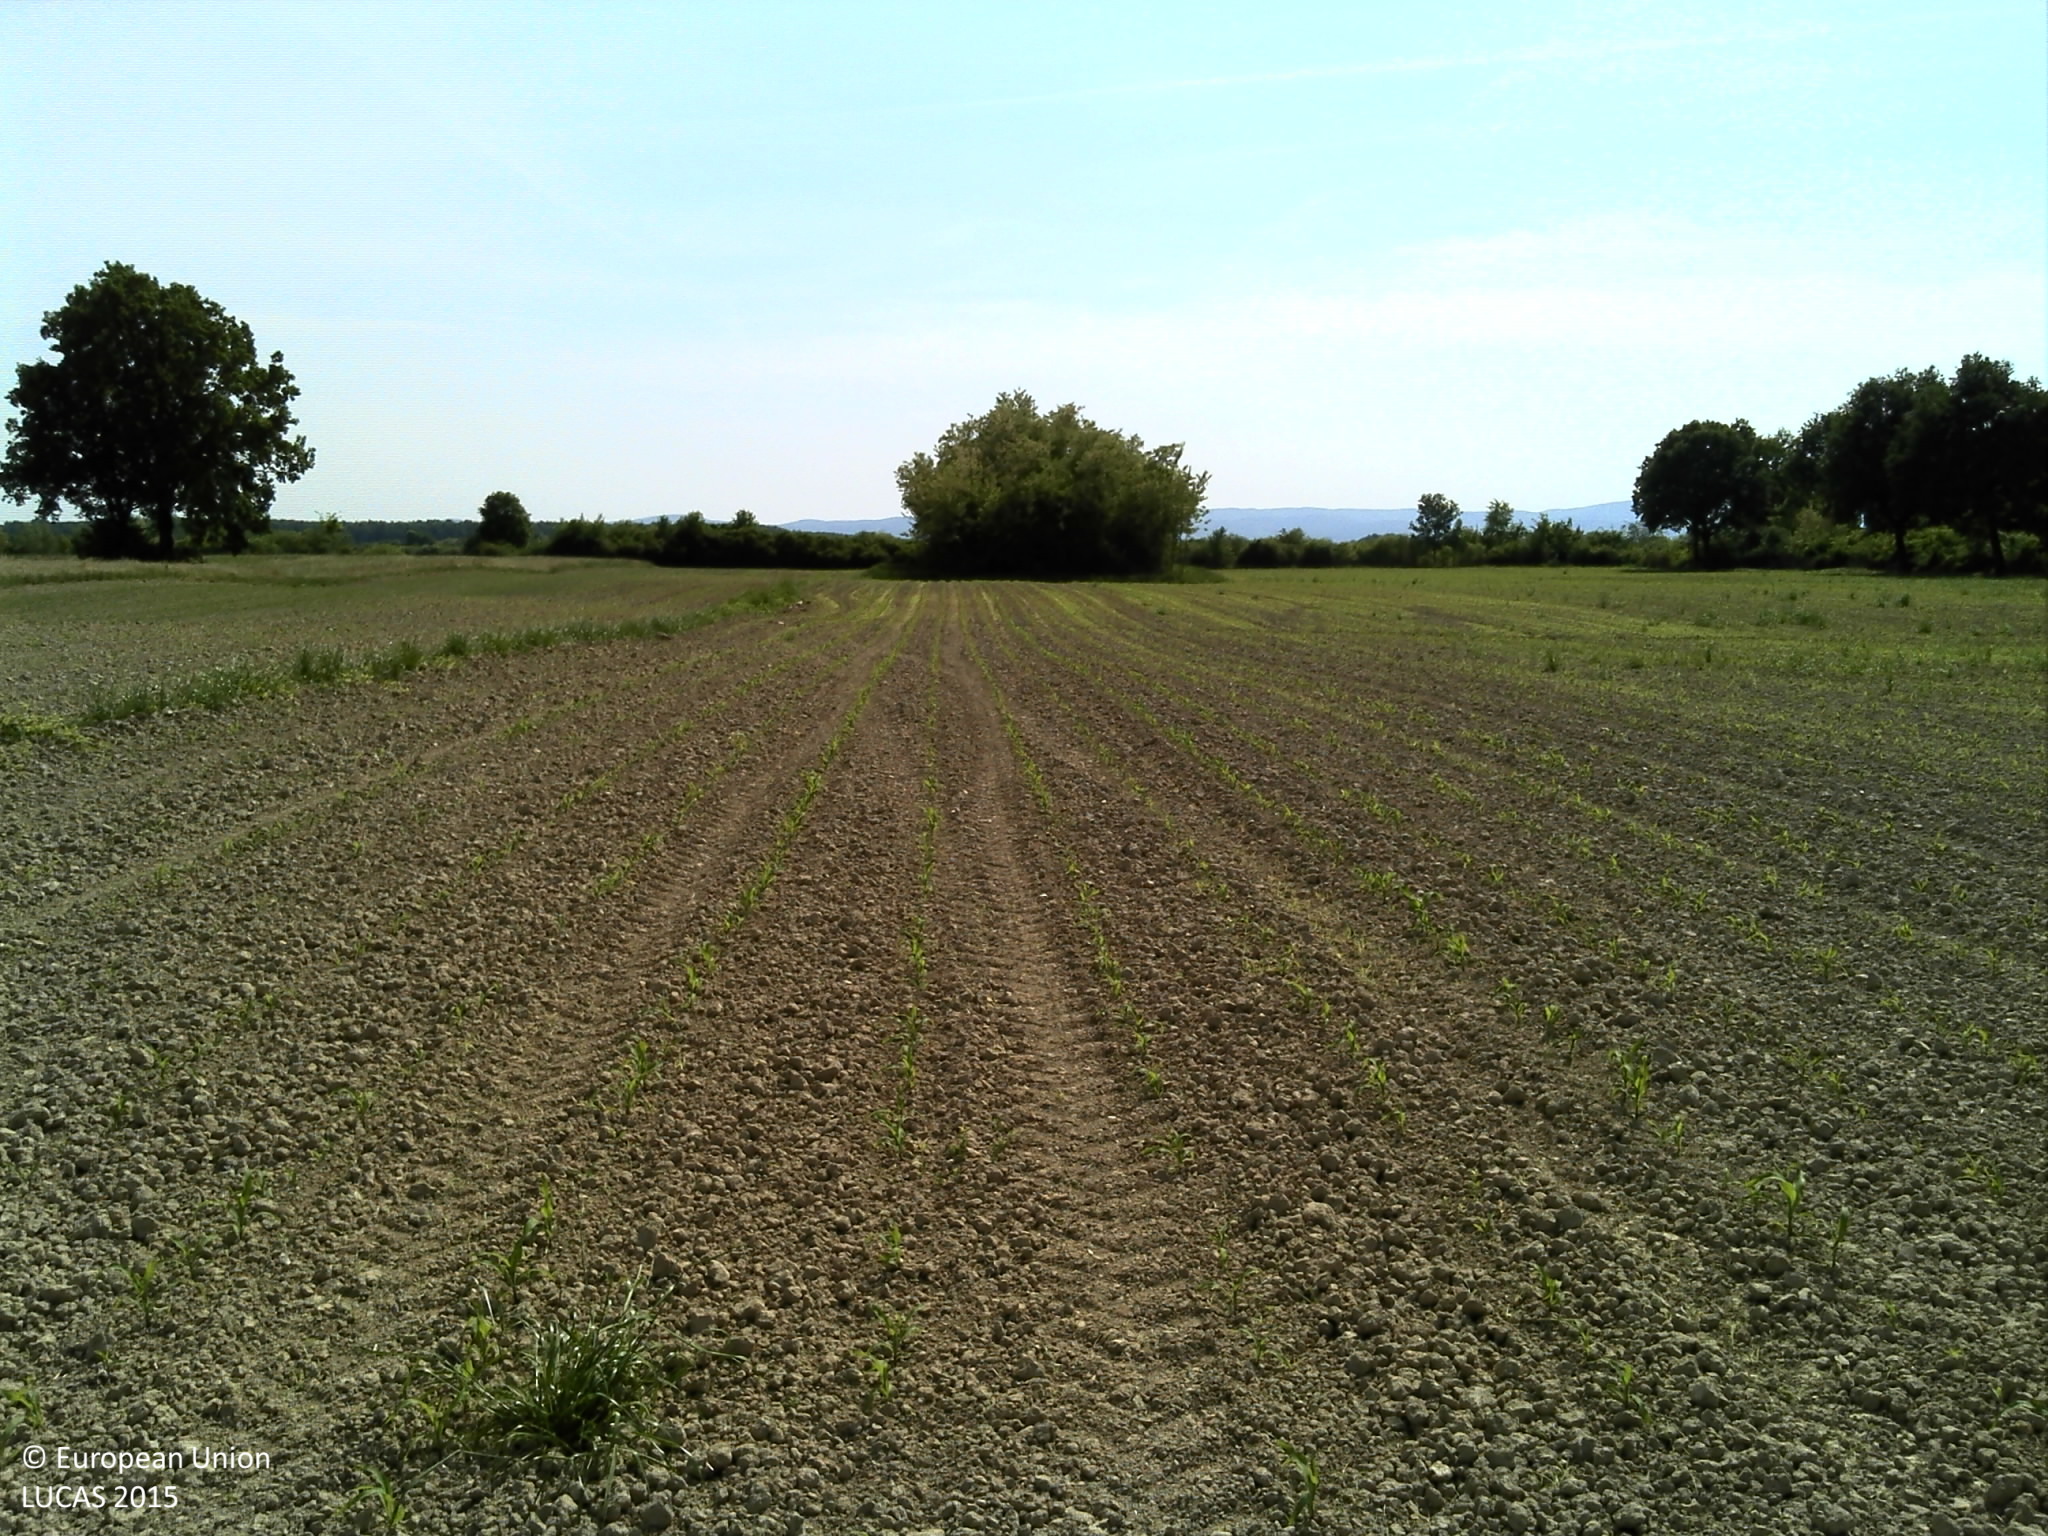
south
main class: Cropland
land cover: Maize
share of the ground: < 10 %
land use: Agriculture (excluding fallow land and kitchen gardens)
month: May
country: HR
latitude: 45.5757
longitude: 18.0649
